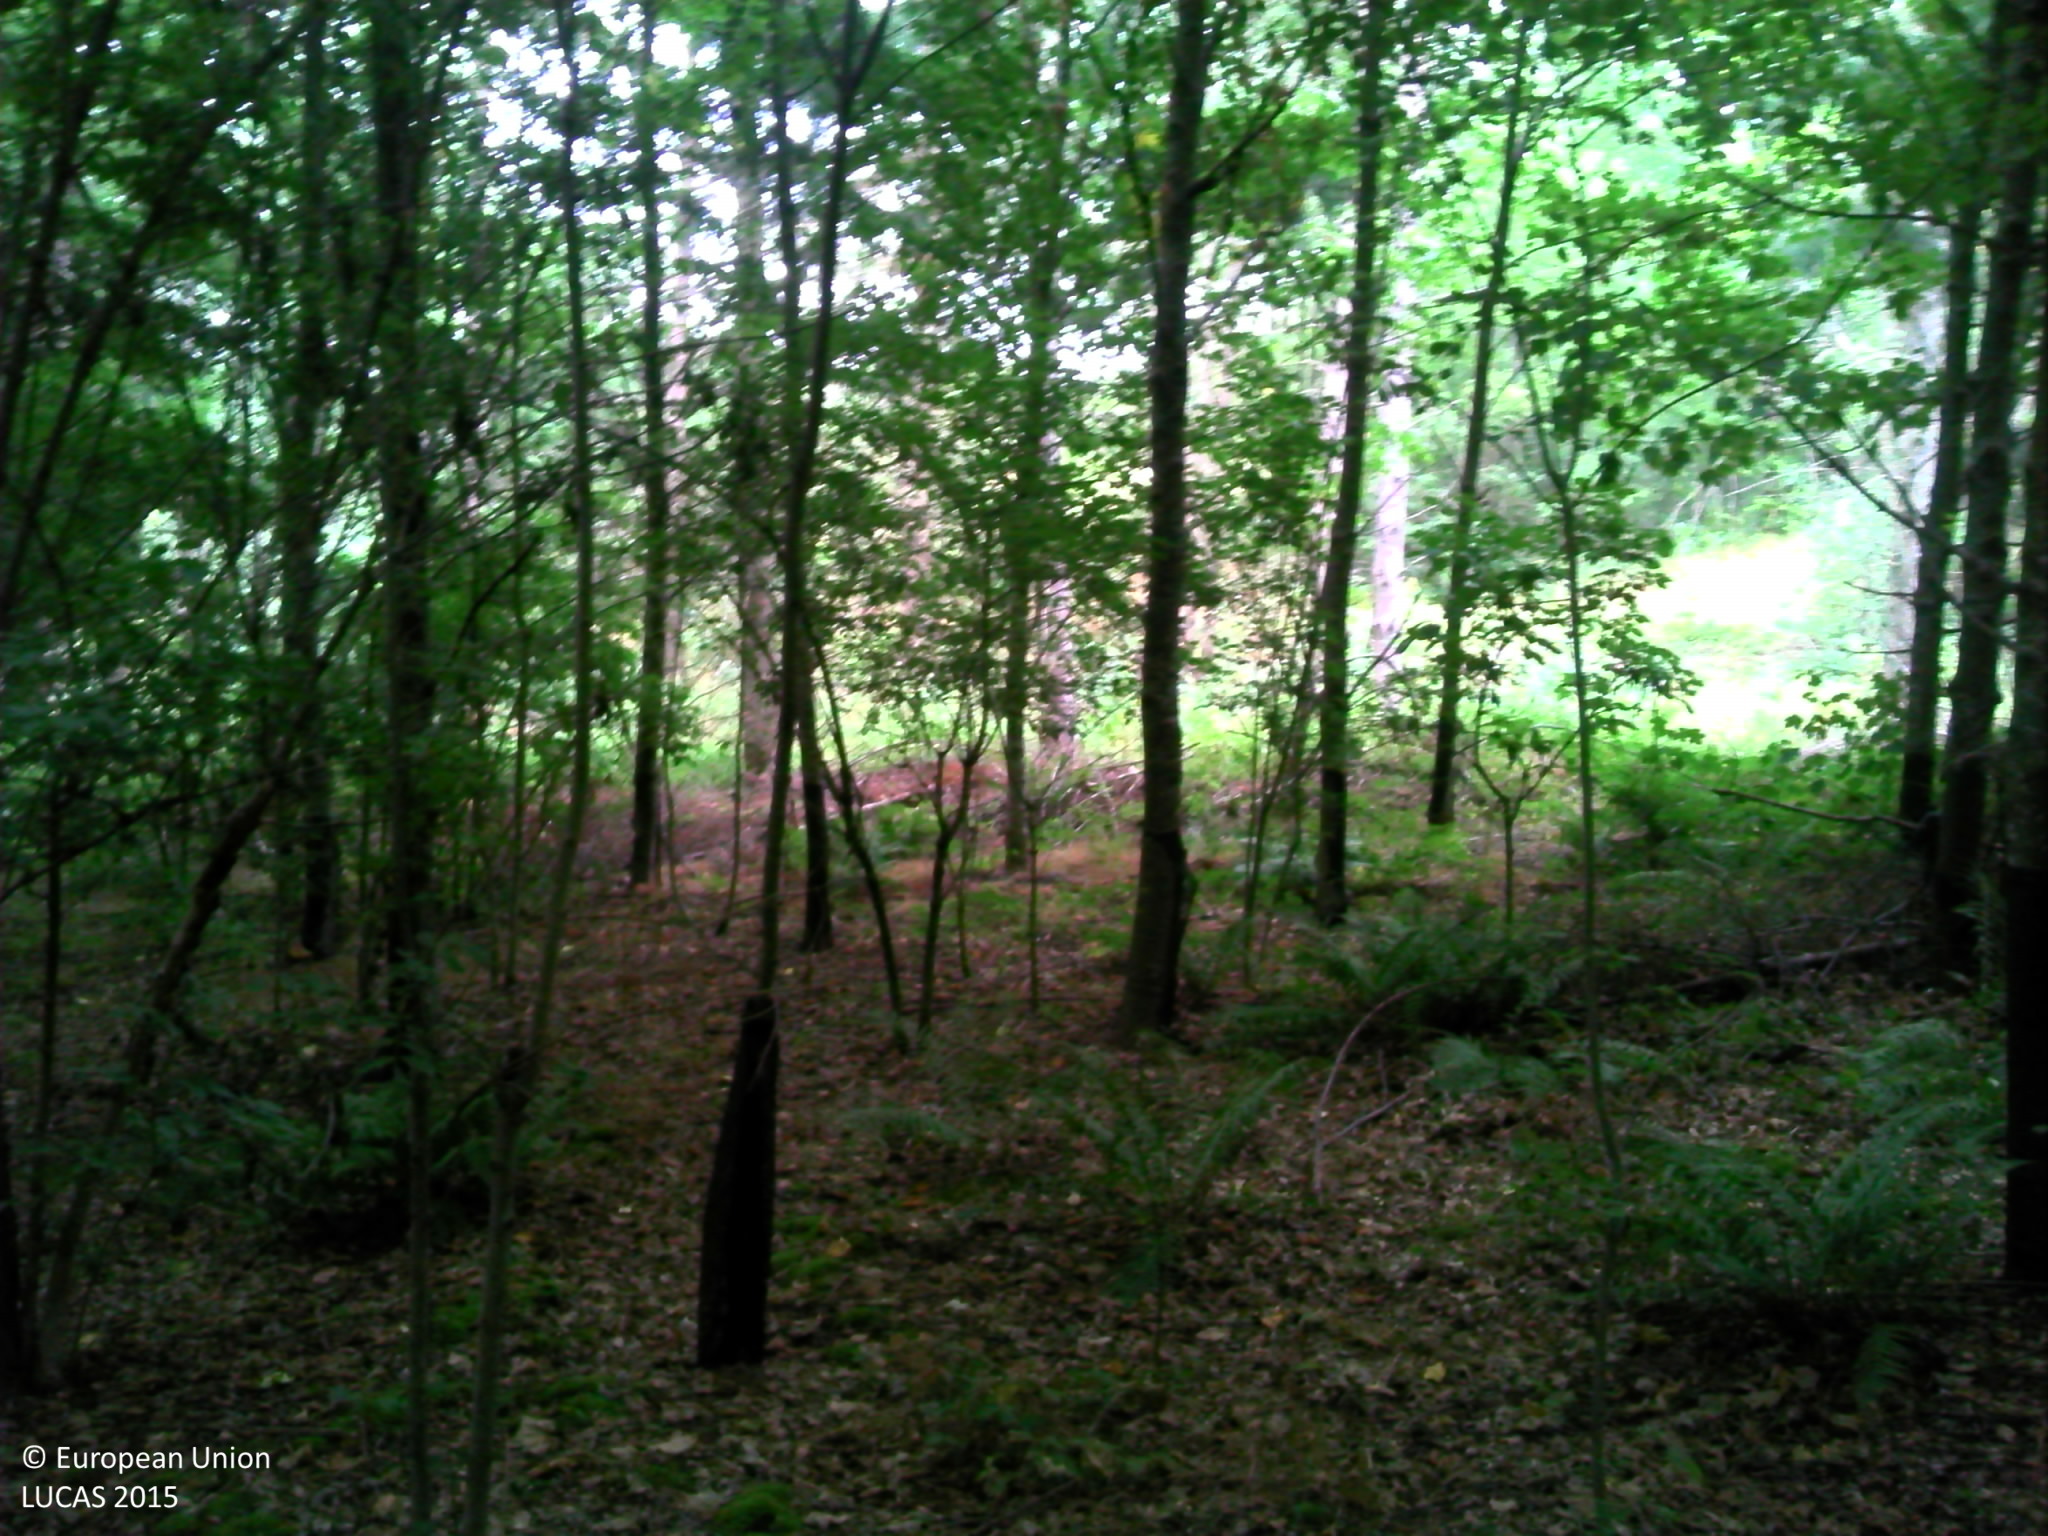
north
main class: Woodland
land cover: Broadleaved woodland
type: exotic forest
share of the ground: > 75 %
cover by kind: broadleaved forest trees 90 %, herbaceous plants 5 %
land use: Forestry
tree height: > 5 m
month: August
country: FR
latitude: 44.9119
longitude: 4.5462
